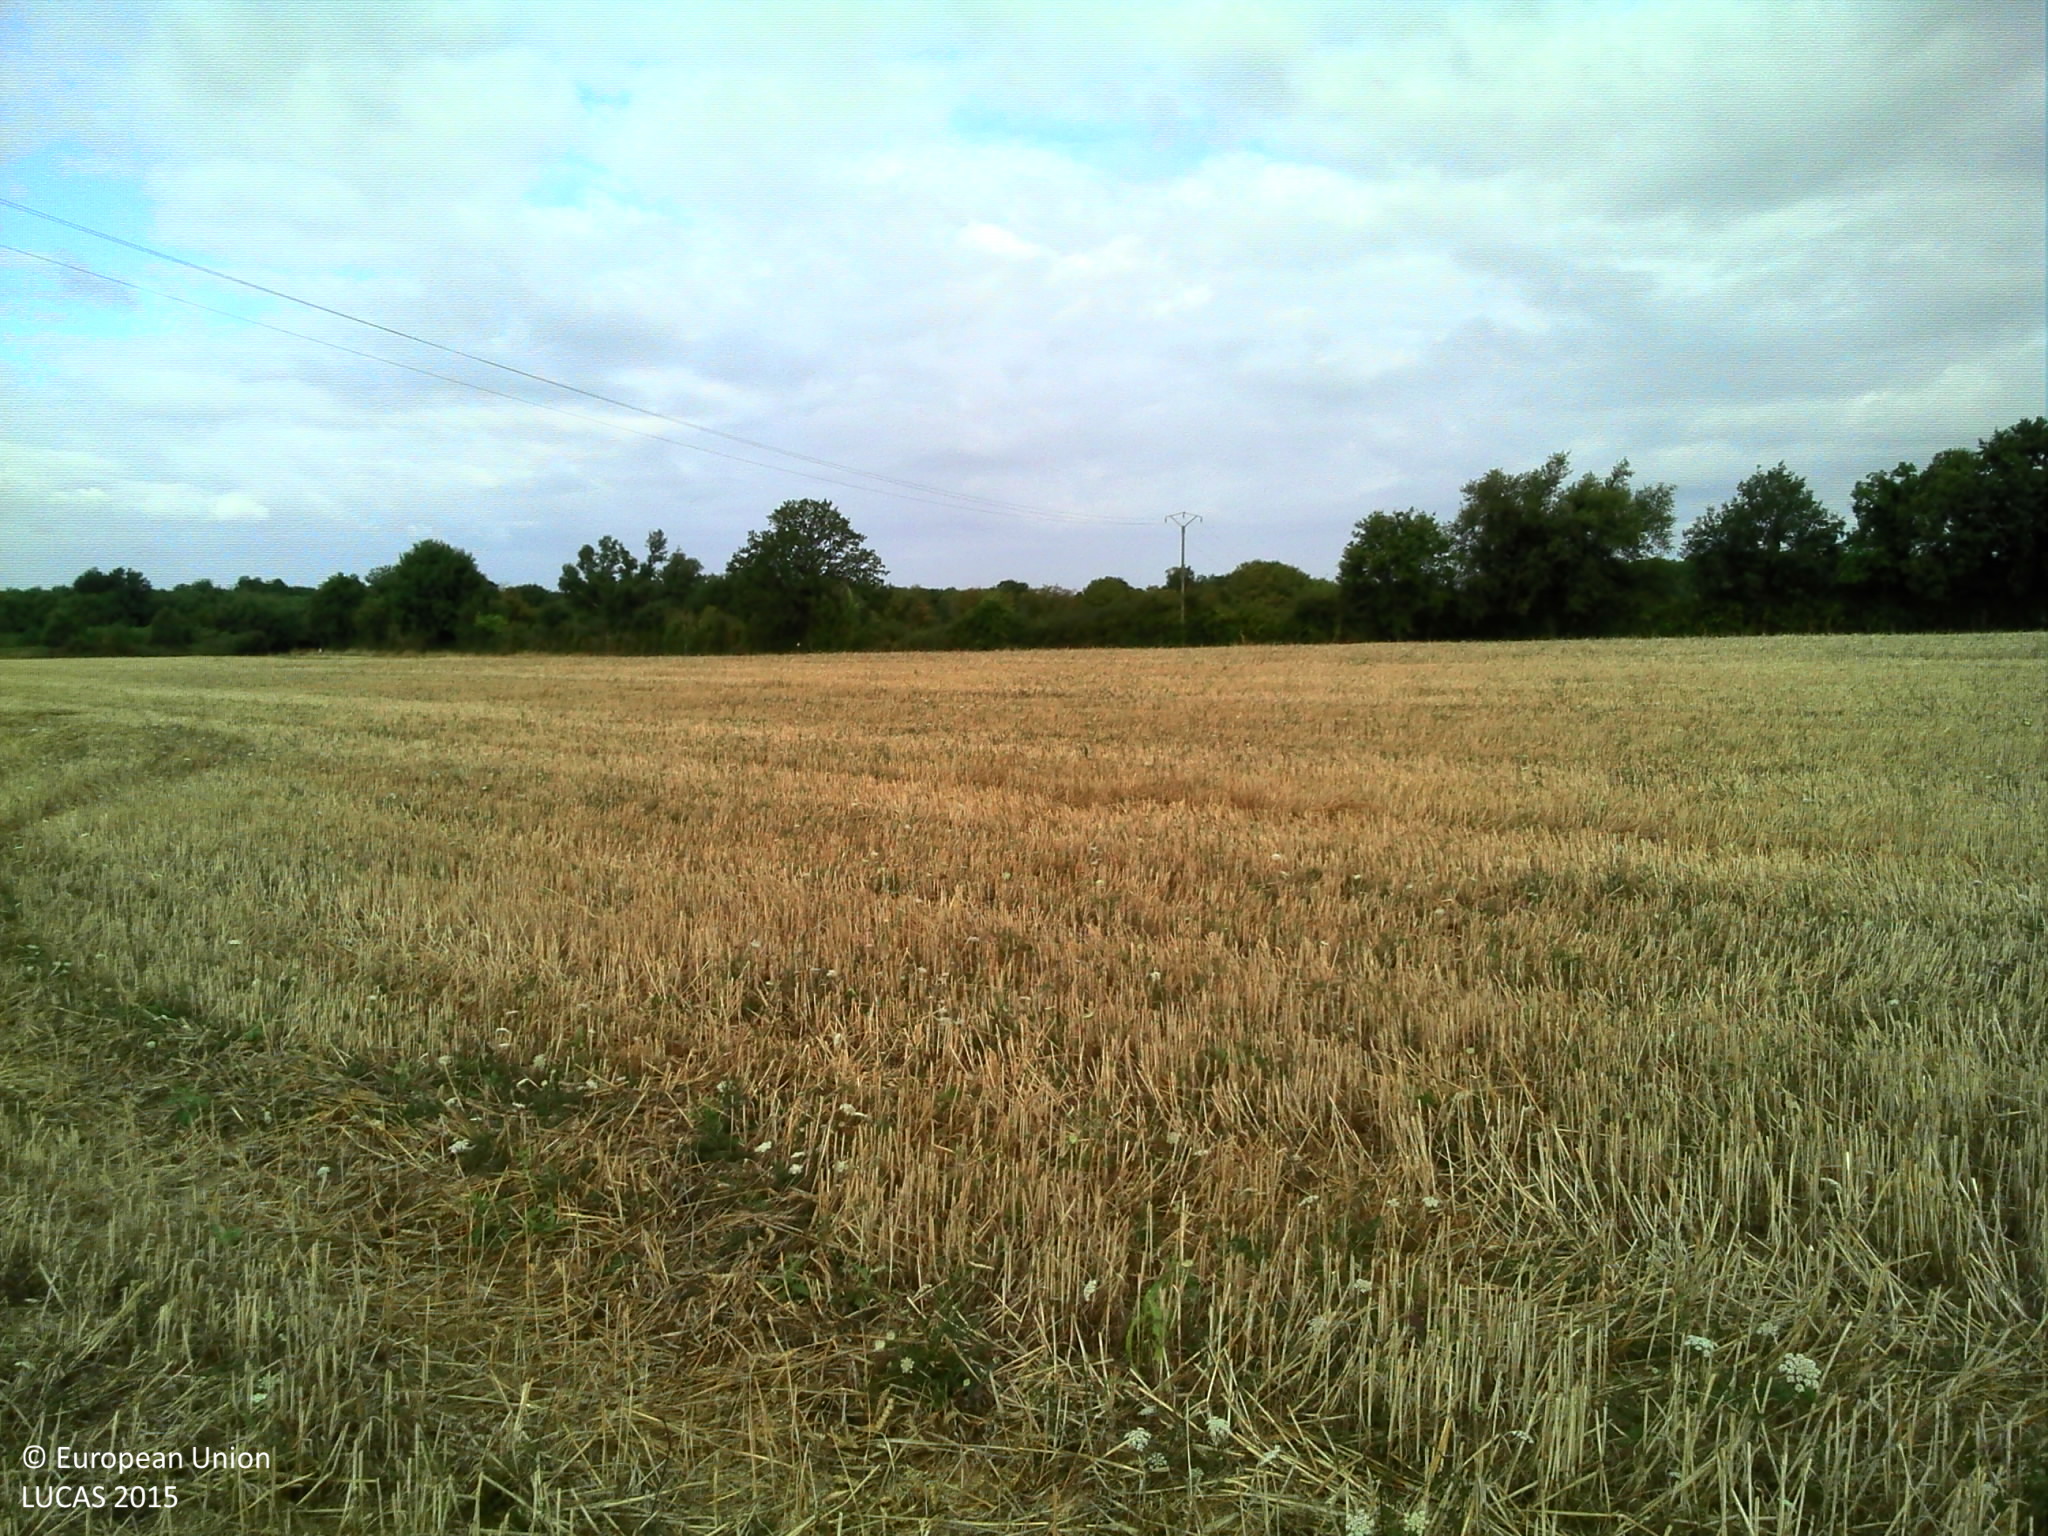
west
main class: Cropland
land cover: Common wheat
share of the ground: 50 - 75 %
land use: Agriculture (excluding fallow land and kitchen gardens)
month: July
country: FR
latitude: 46.3114
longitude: 0.3338
